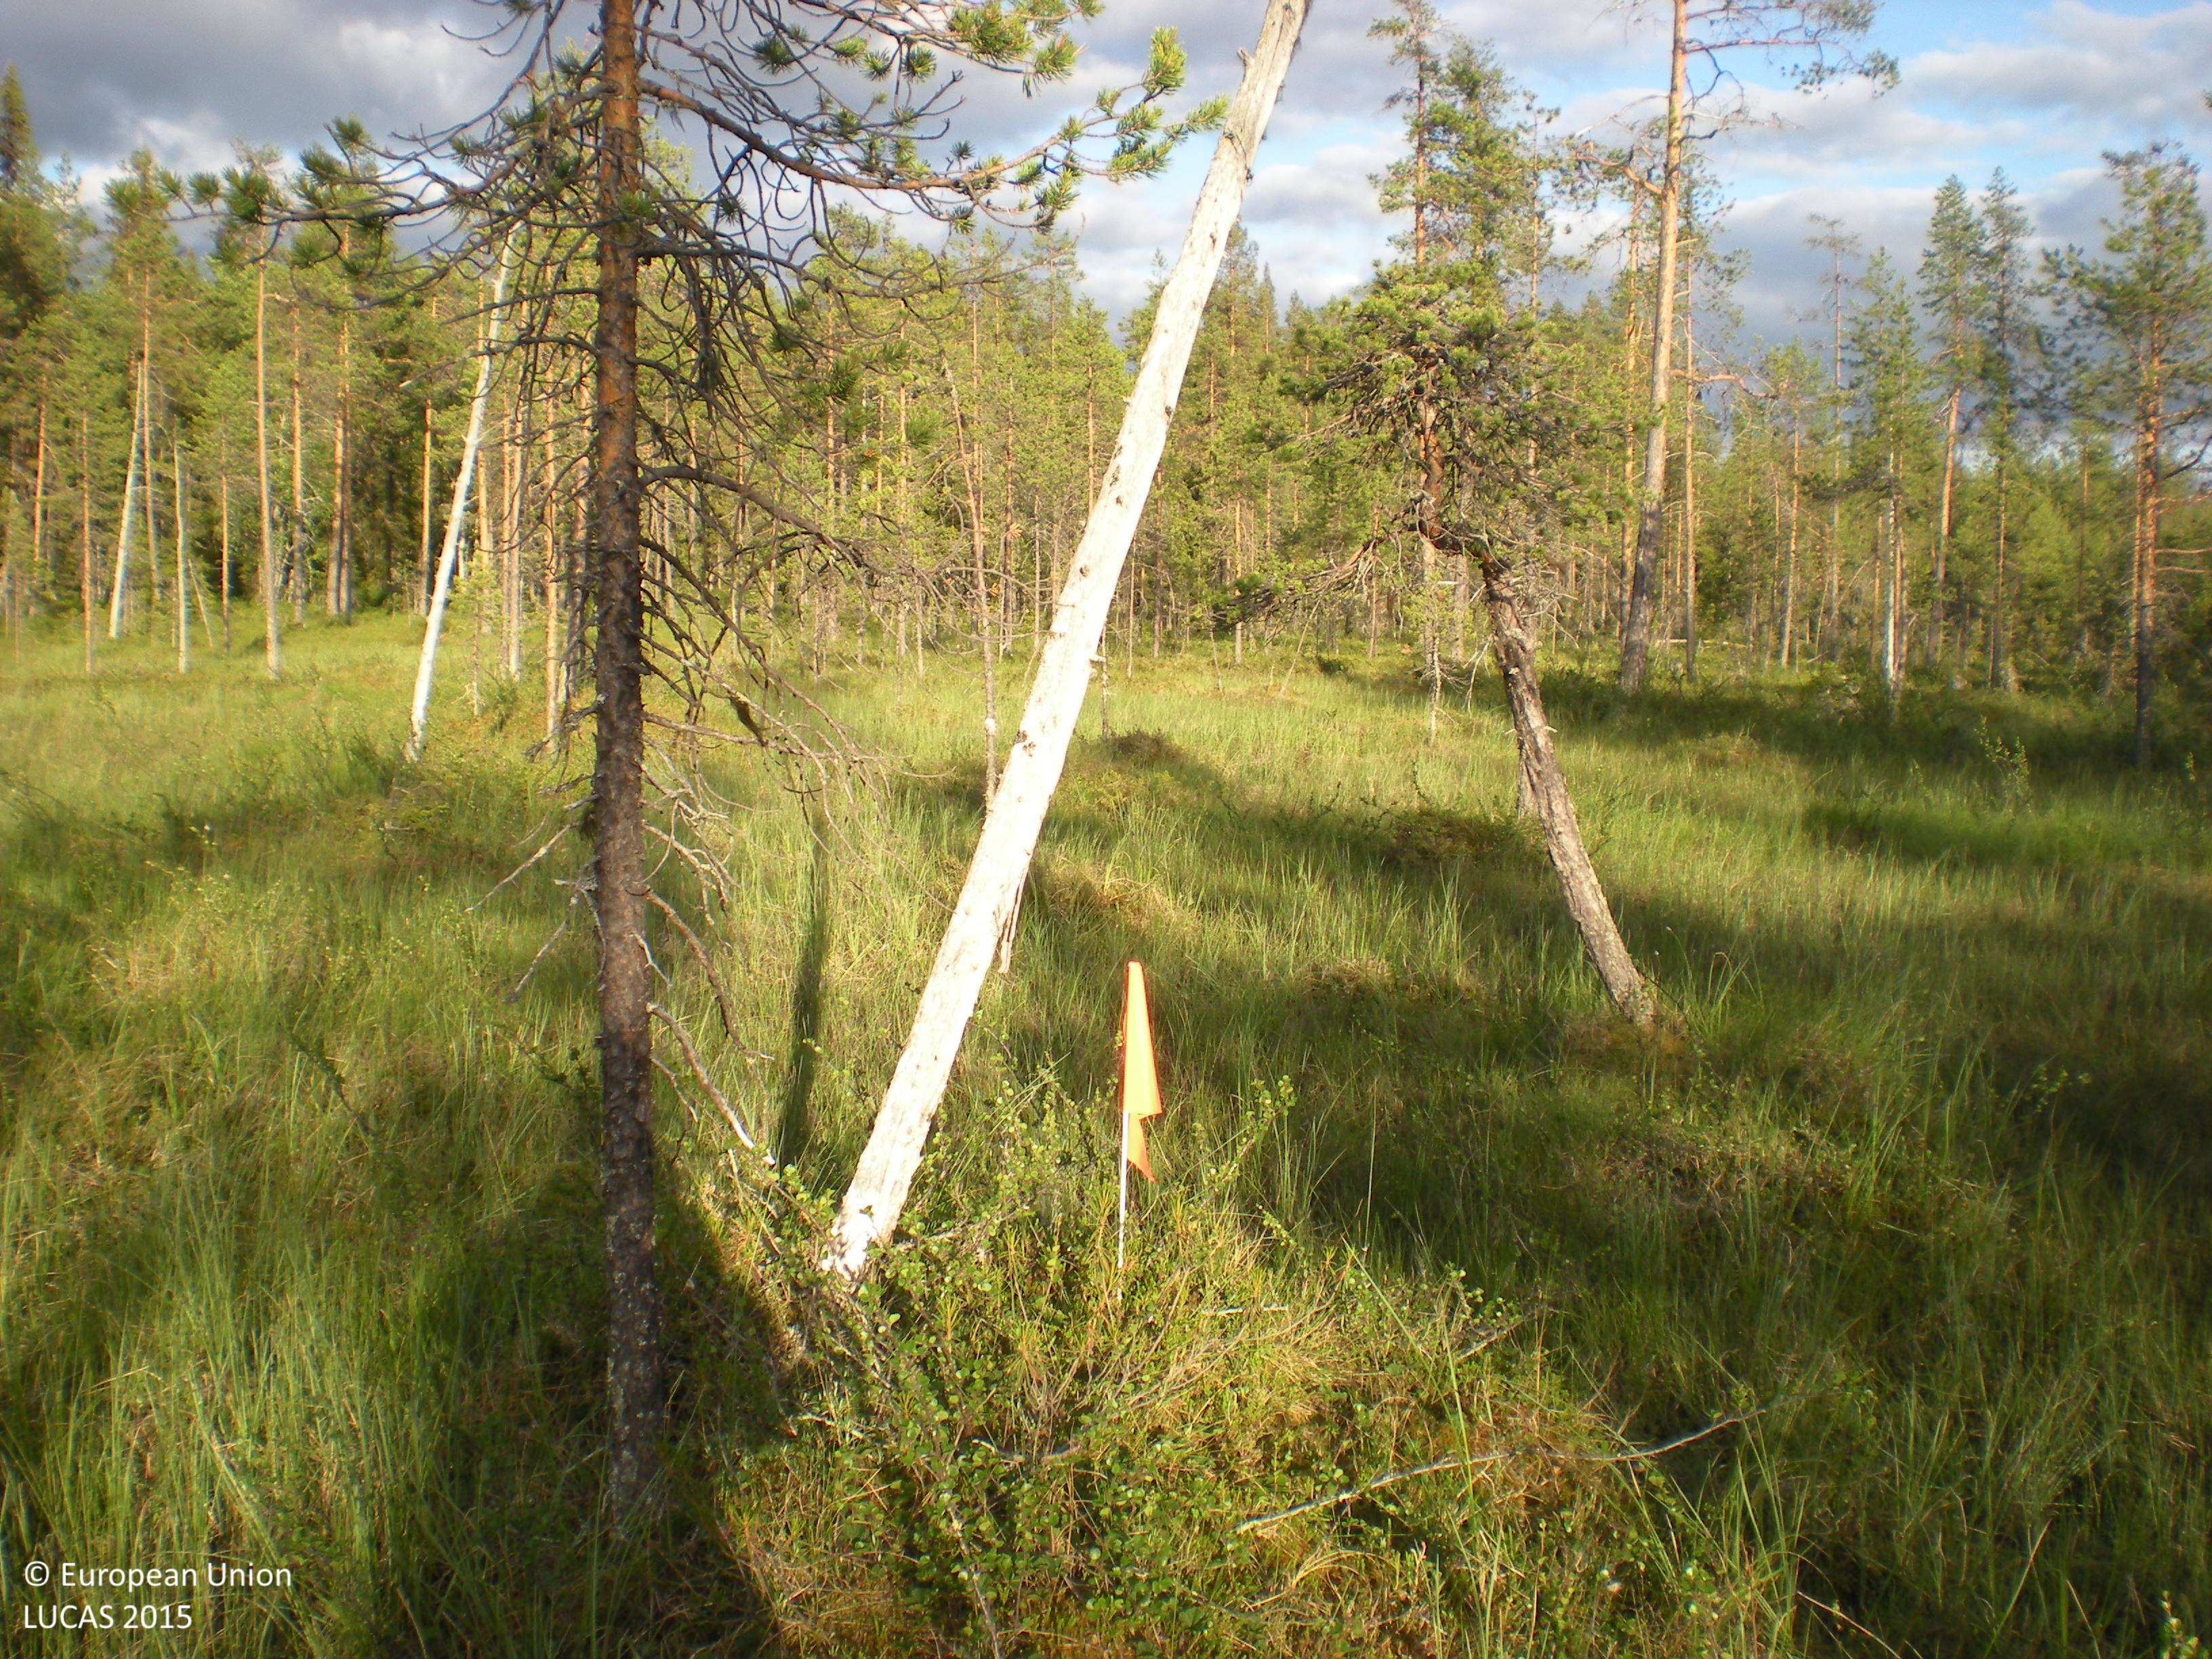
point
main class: Woodland
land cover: Pine dominated mixed woodland
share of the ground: < 10 %
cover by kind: lichens and mosses 55 %, herbaceous plants 25 %, coniferous forest trees 10 %, broadleaved forest trees 5 %, shrubs 5 %
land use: Semi-natural and natural areas not in use
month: July
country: SE
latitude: 65.4816
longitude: 18.1016
